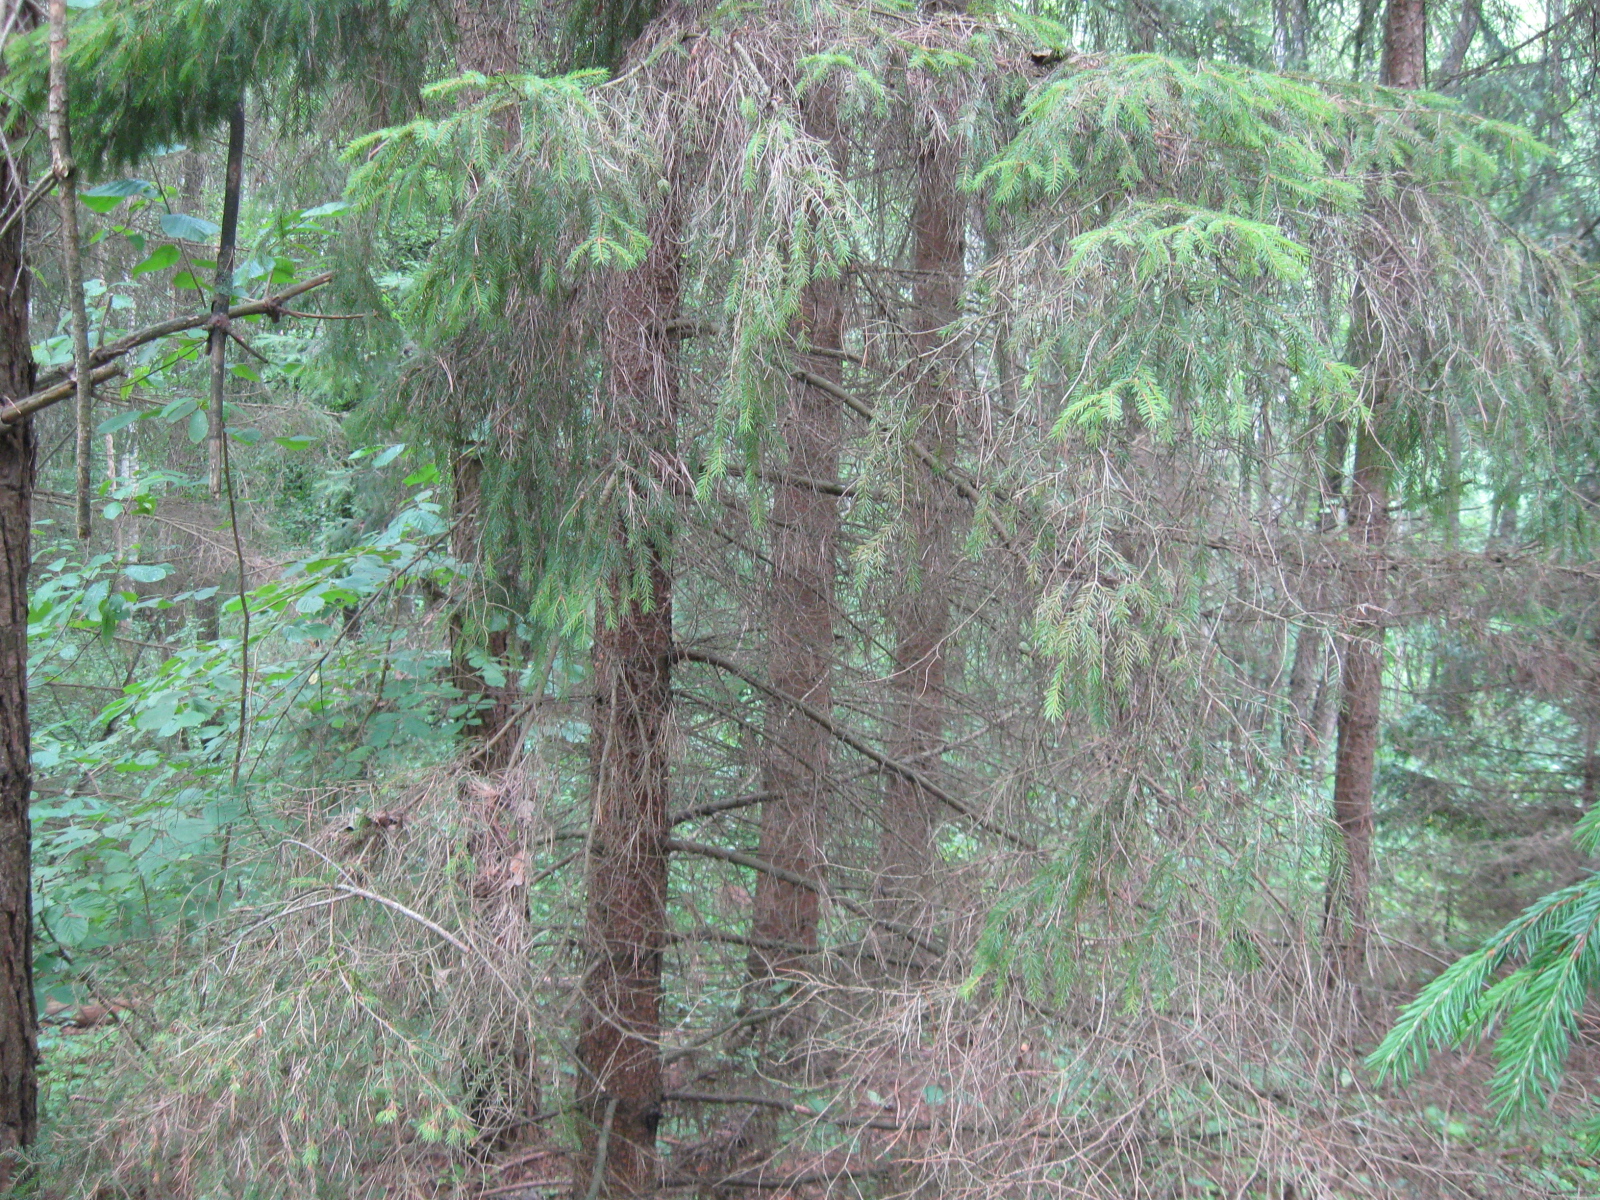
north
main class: Woodland
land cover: Pine dominated coniferous woodland
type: hemiboreal forest and nemoral coniferous forest and mixed broadleaved-coniferous forest
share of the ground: > 75 %
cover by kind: coniferous forest trees 90 %, broadleaved forest trees 5 %, herbaceous plants 5 %
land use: Forestry
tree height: > 5 m
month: July
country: LT
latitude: 54.2864
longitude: 24.2770
